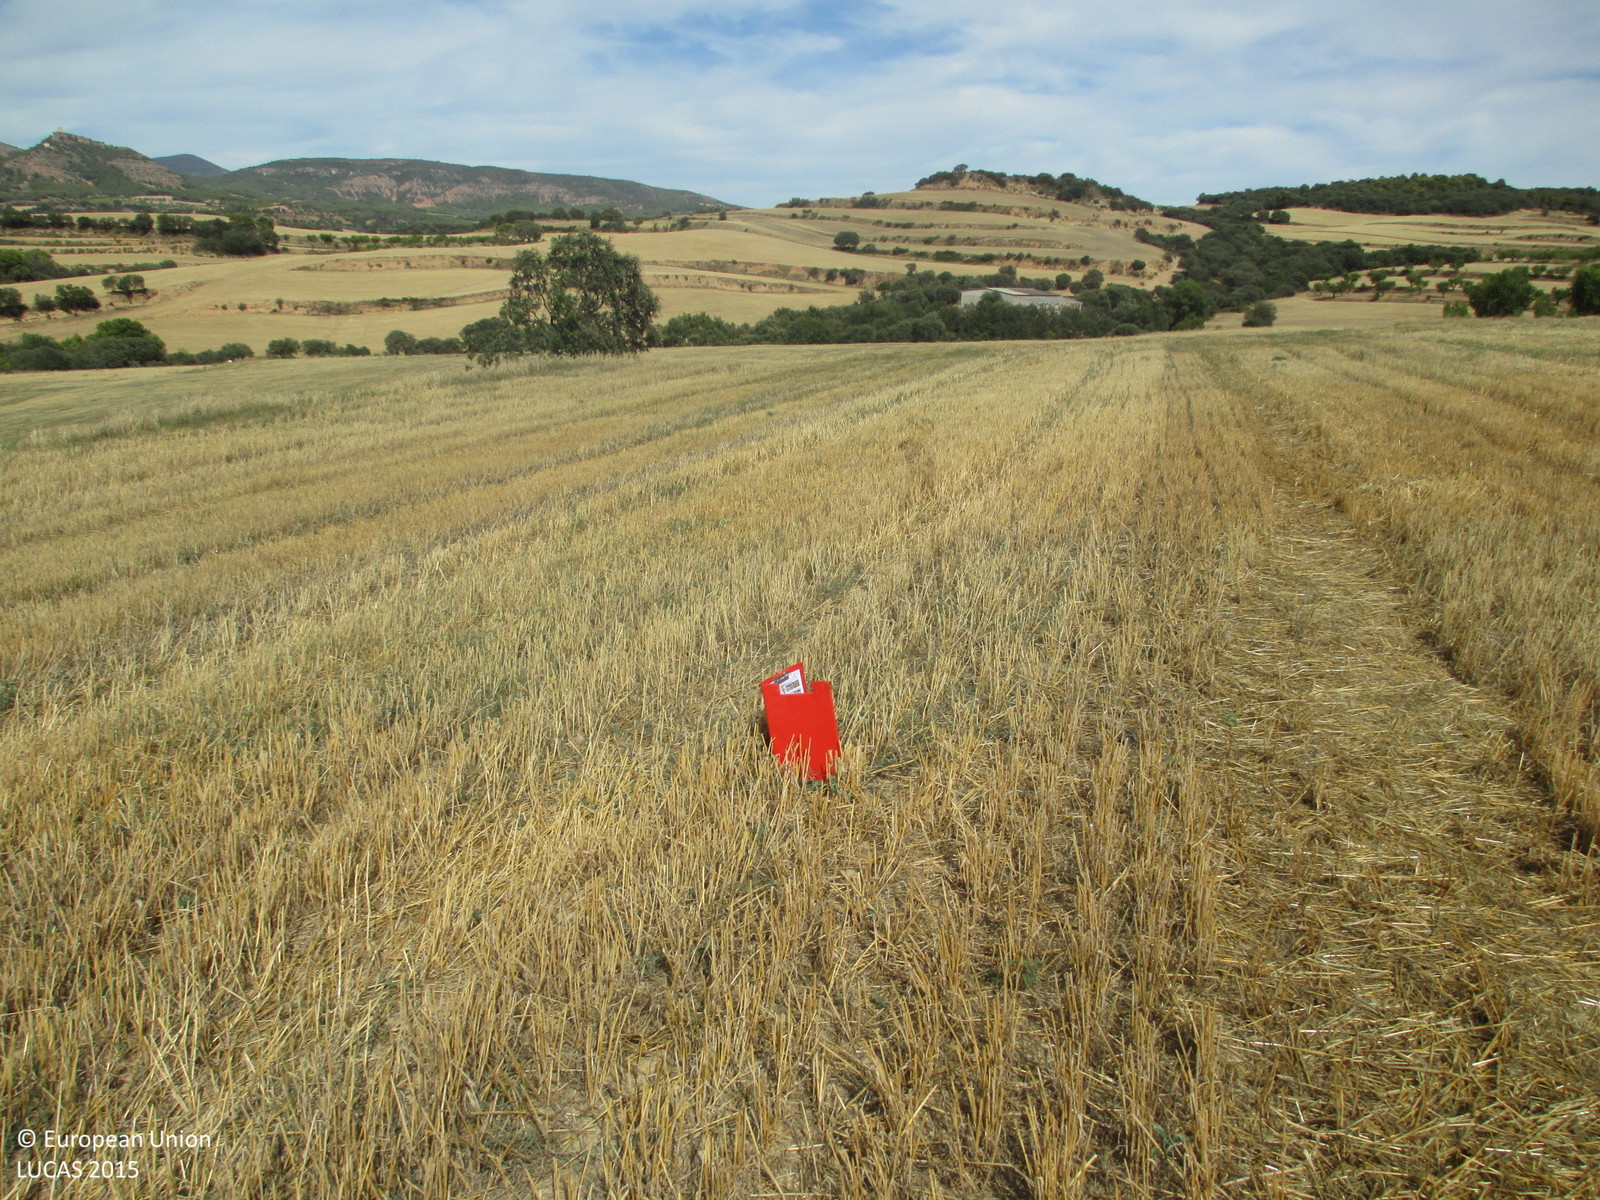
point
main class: Cropland
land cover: Barley
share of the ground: < 10 %
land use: Agriculture (excluding fallow land and kitchen gardens)
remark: Harvested field
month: July
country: ES
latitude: 41.9577
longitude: 0.3681
